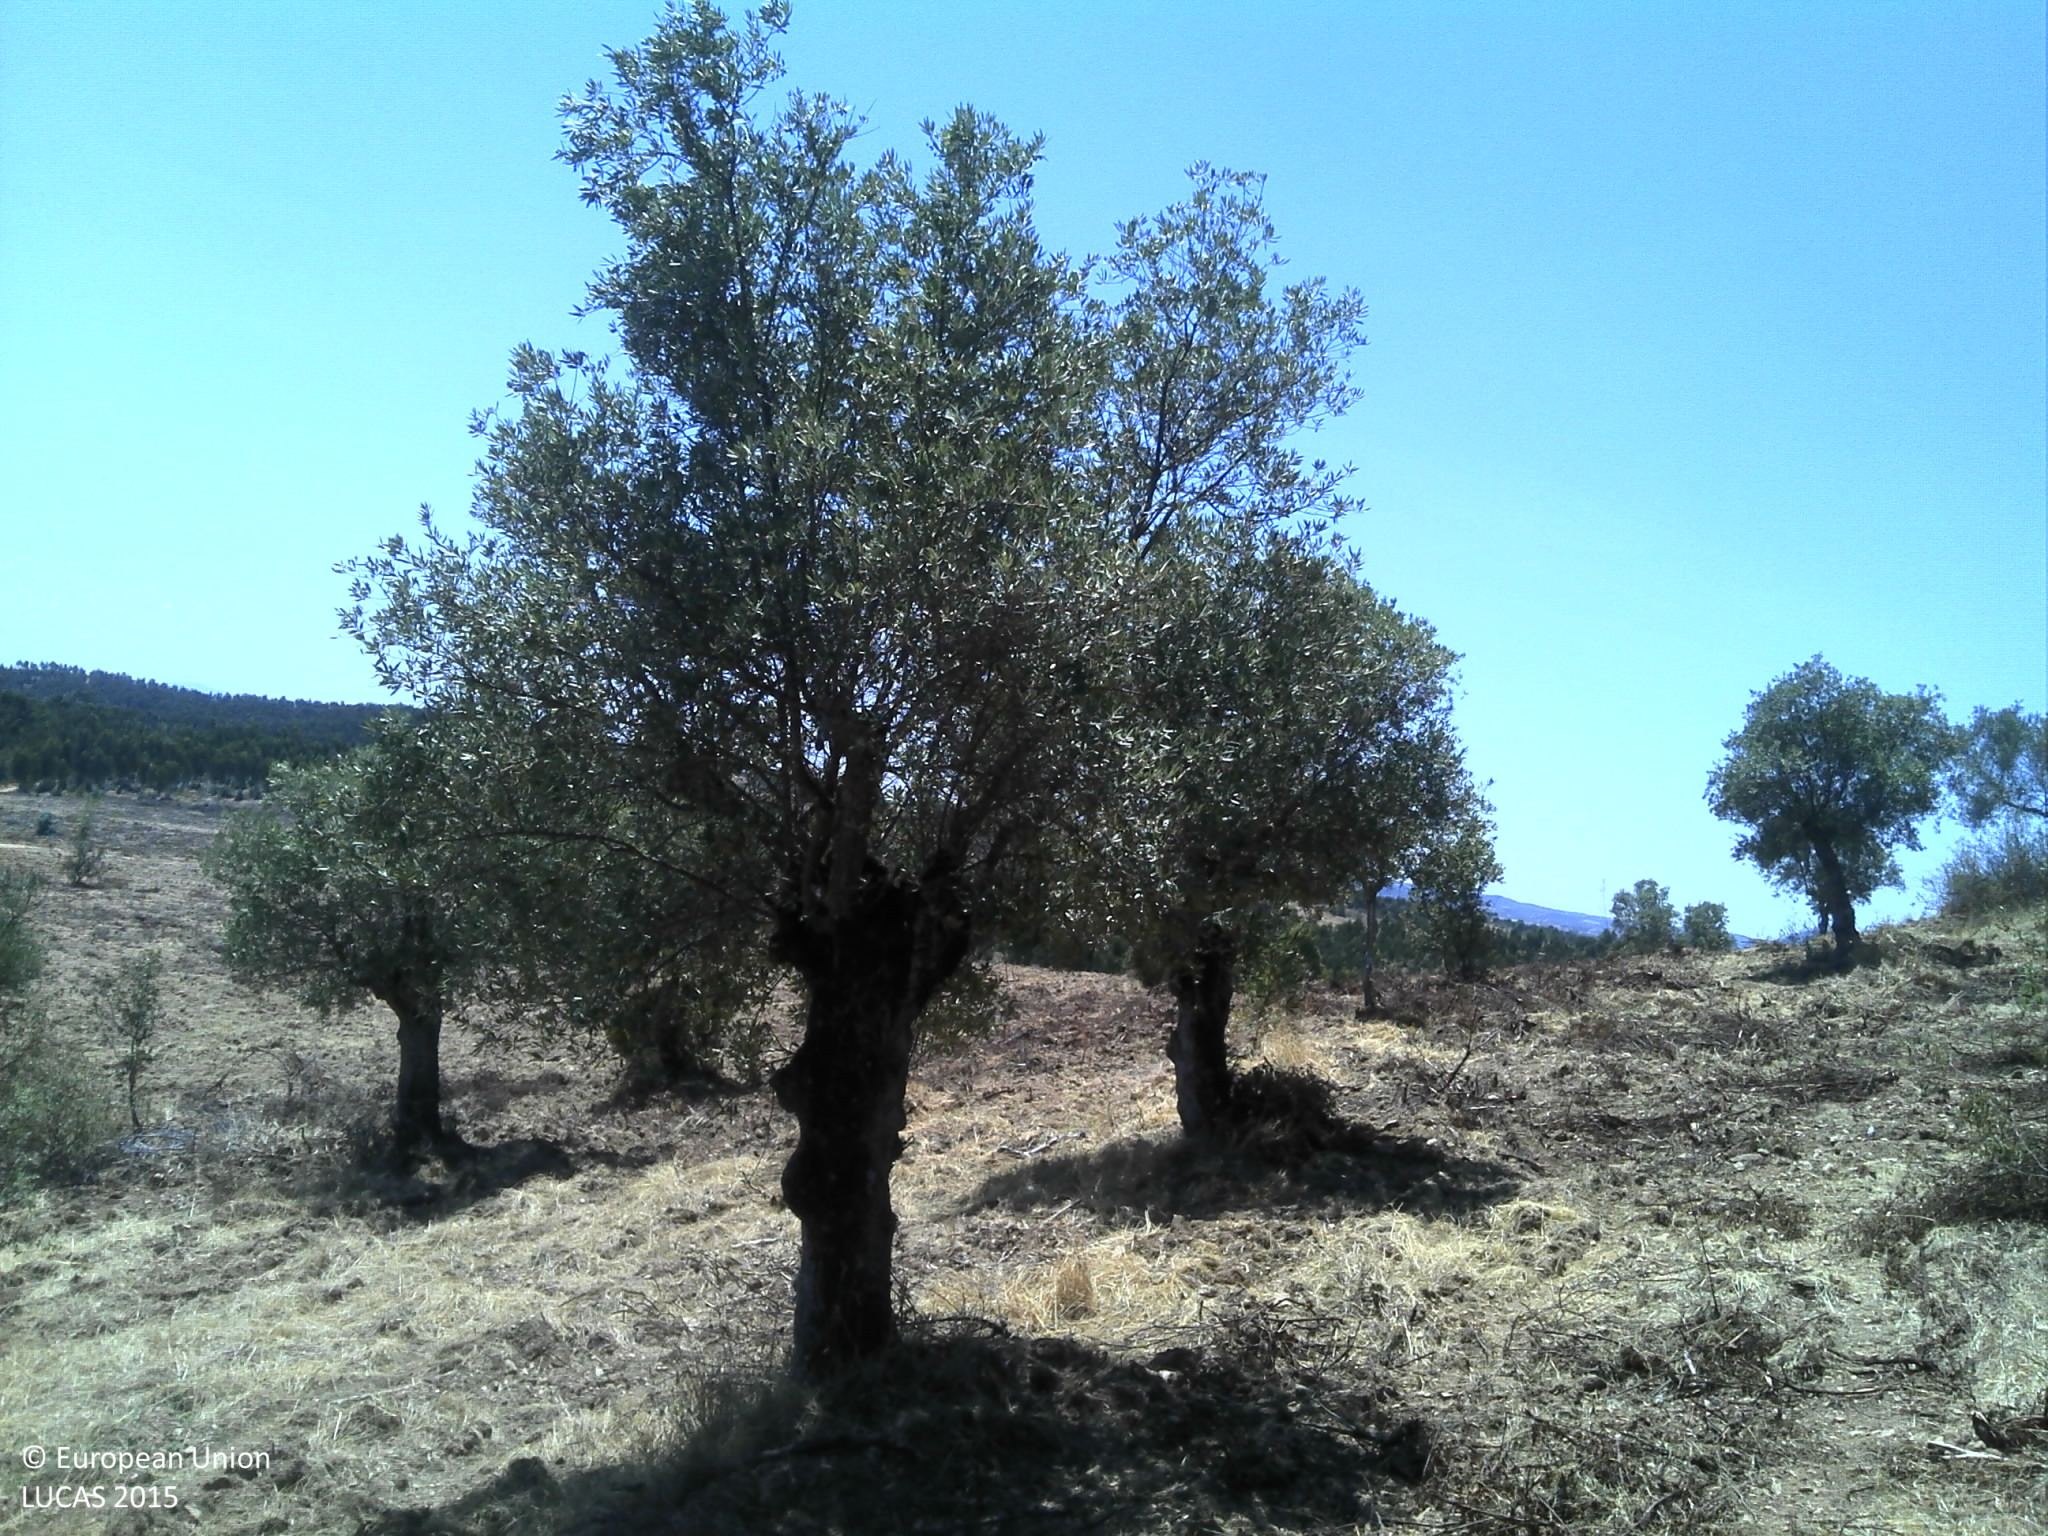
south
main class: Cropland
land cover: Olive groves
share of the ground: 25 - 50 %
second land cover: Shrubland without tree cover
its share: 25 - 50 %
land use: Agriculture (excluding fallow land and kitchen gardens)
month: July
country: PT
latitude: 39.7431
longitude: -7.5450
